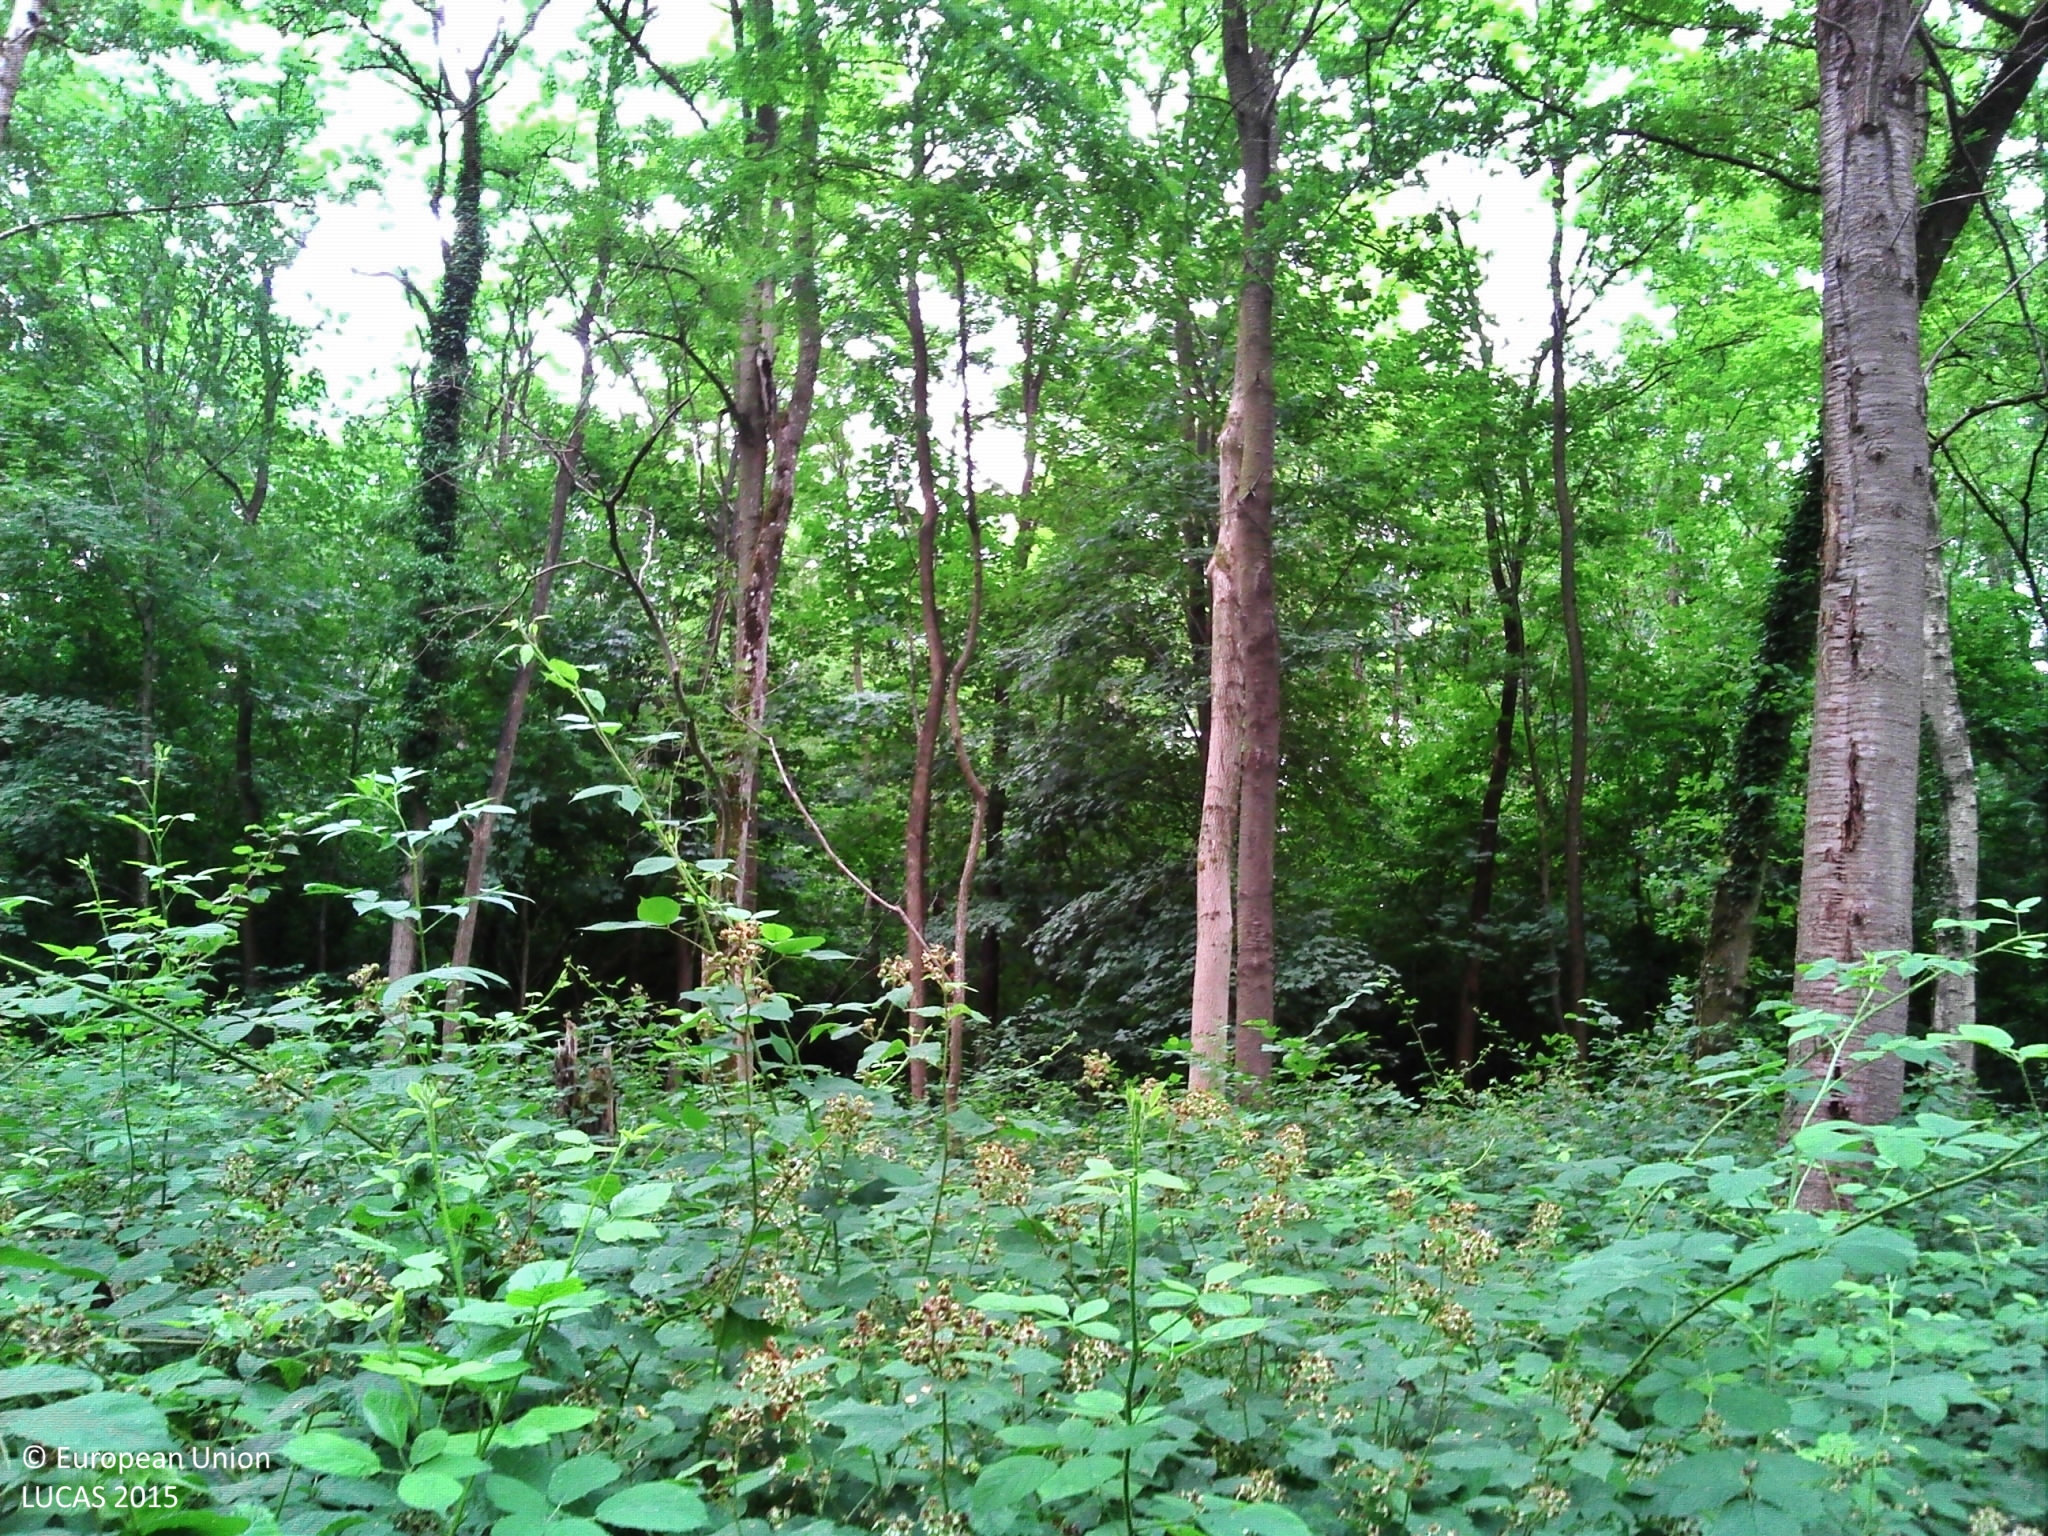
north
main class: Woodland
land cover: Broadleaved woodland
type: mesophytic deciduous forest
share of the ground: > 75 %
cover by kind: broadleaved forest trees 70 %, shrubs 15 %, herbaceous plants 15 %
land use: Forestry
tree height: > 5 m
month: July
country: FR
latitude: 49.3835
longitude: 1.8152
